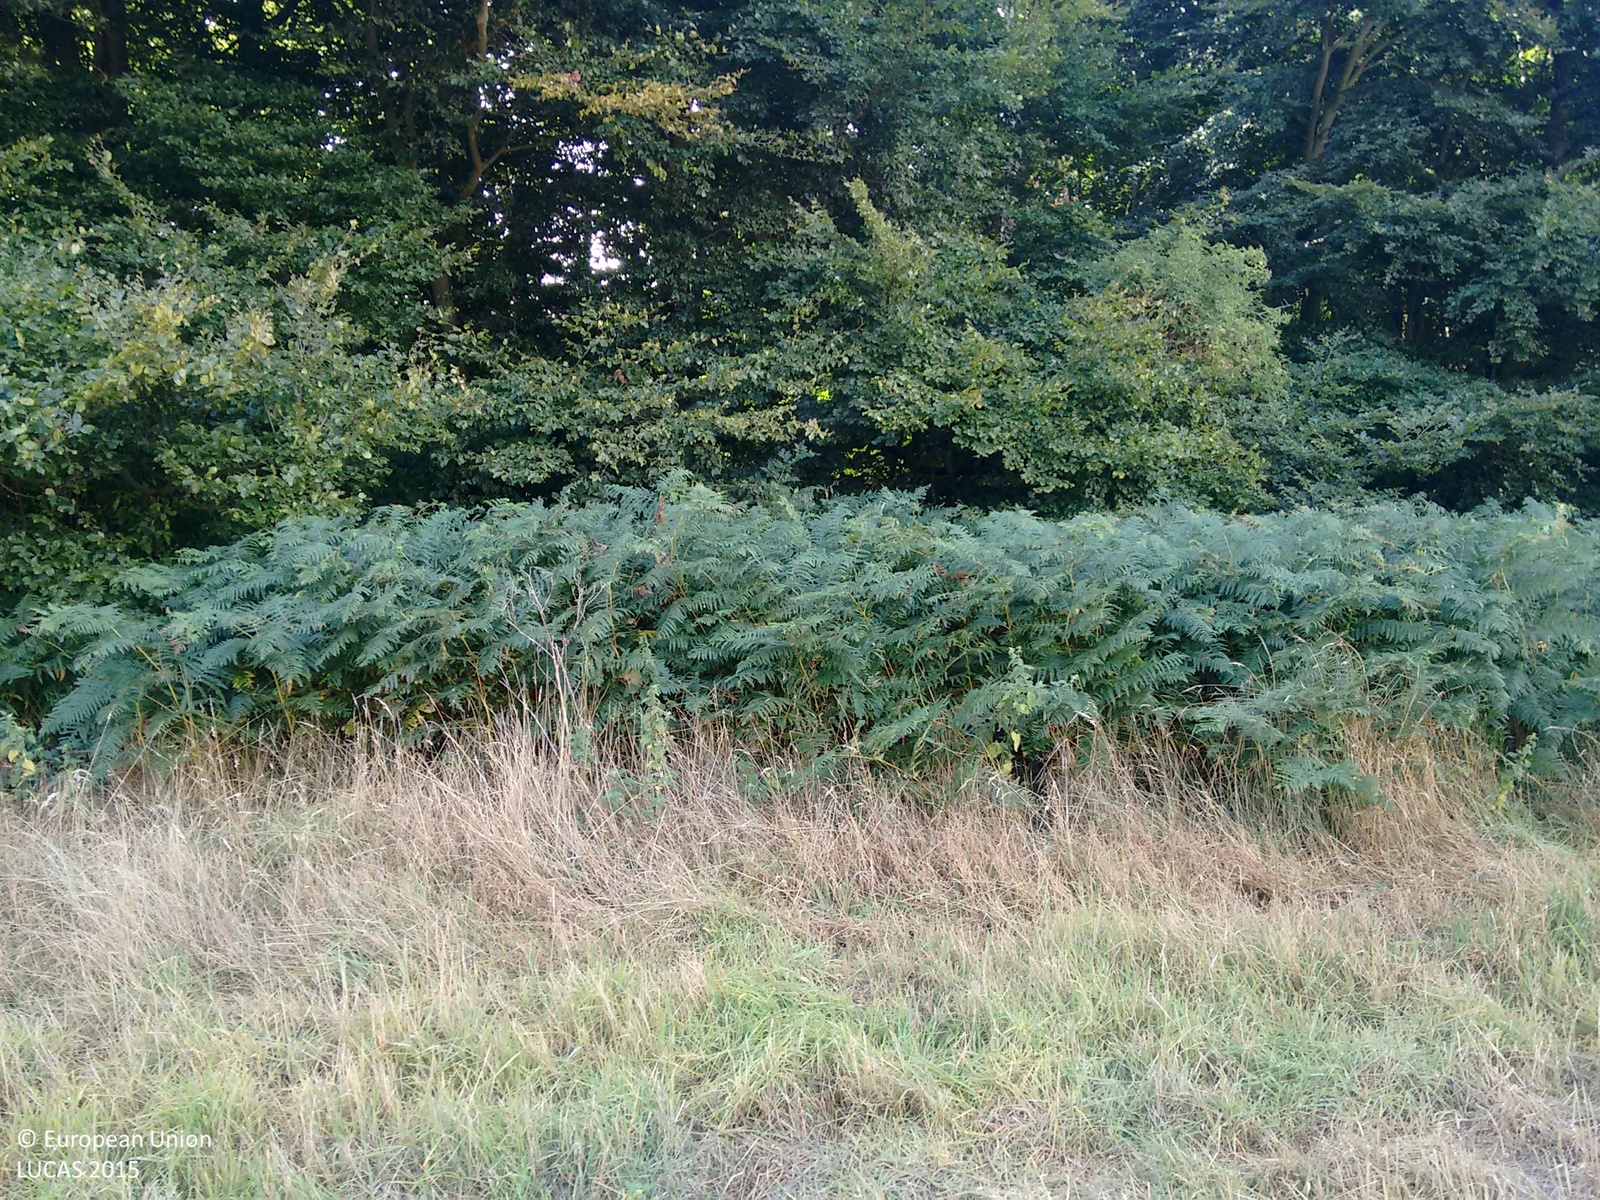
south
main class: Cropland
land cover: Barley
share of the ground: 50 - 75 %
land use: Agriculture (excluding fallow land and kitchen gardens)
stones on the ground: < 10 %
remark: Harvested field
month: August
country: GB
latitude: 52.0285
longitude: 1.3952
